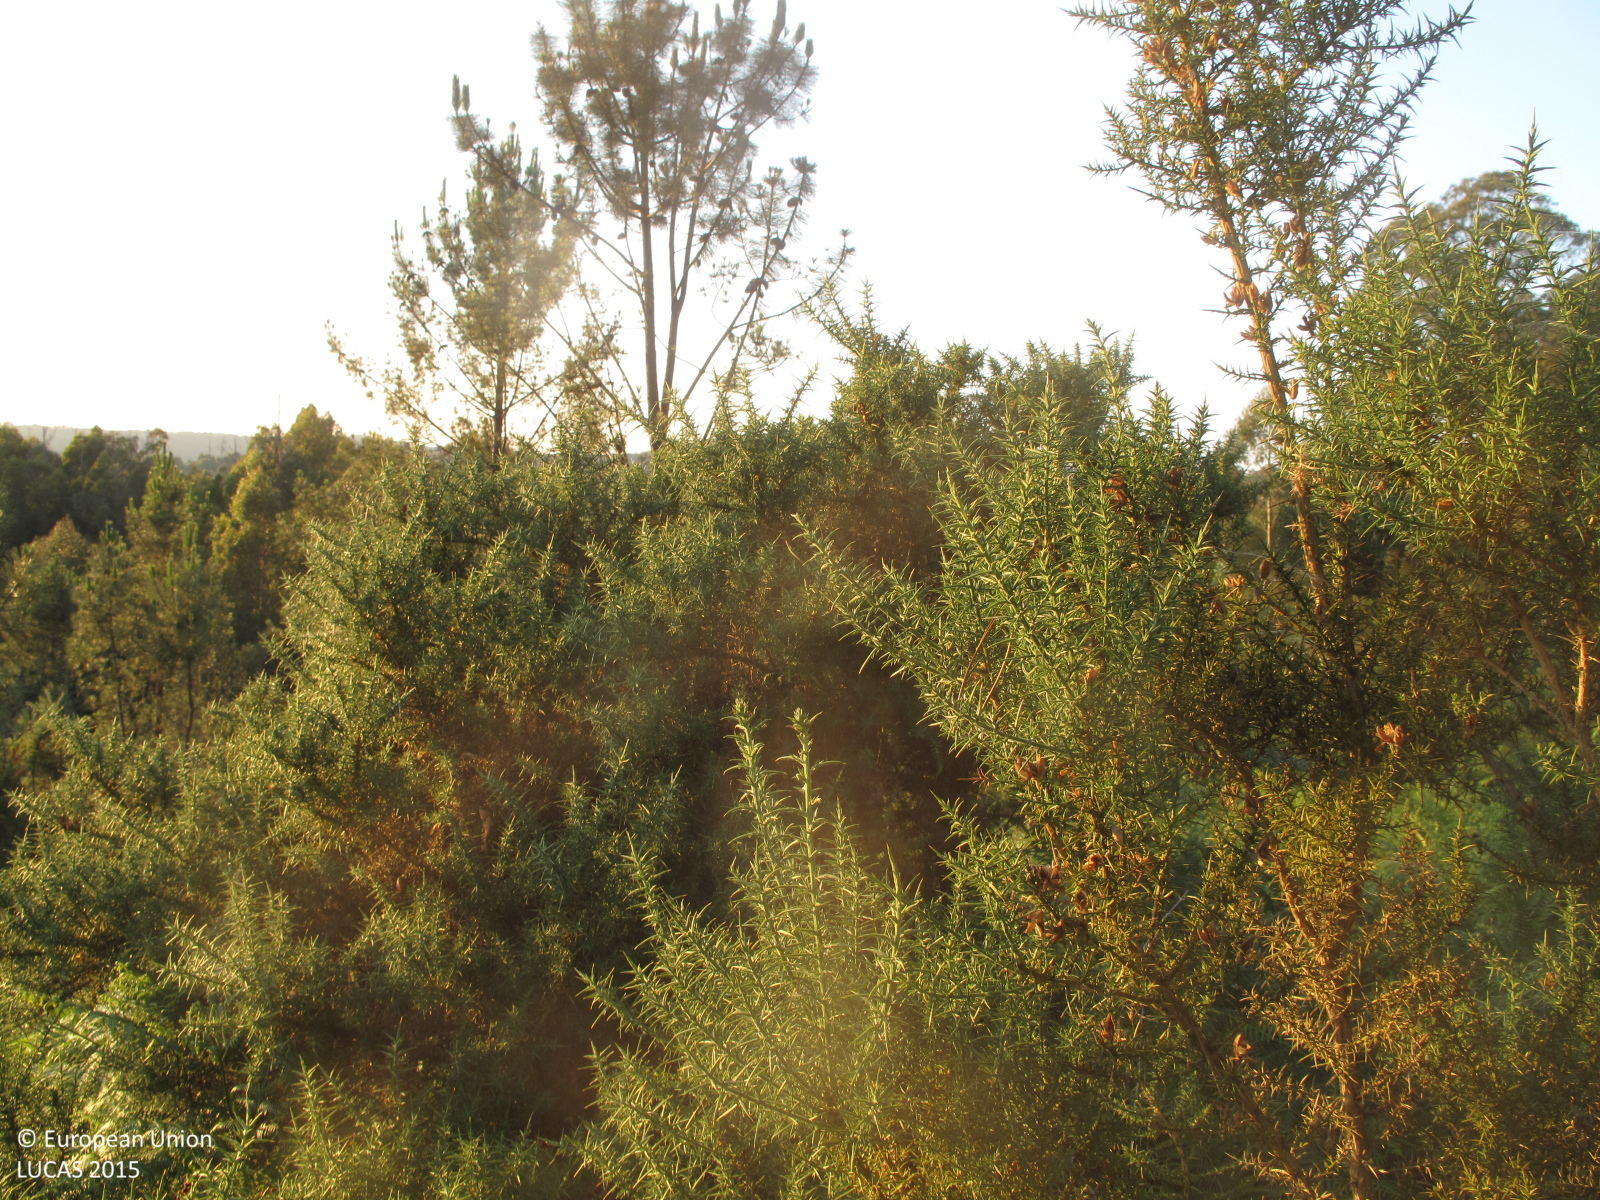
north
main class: Shrubland
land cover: Shrubland with sparse tree cover
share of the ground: > 75 %
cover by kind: shrubs 75 %, herbaceous plants 20 %, coniferous forest trees 5 %
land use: Semi-natural and natural areas not in use
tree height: > 5 m
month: July
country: ES
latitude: 43.2949
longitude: -8.0031
